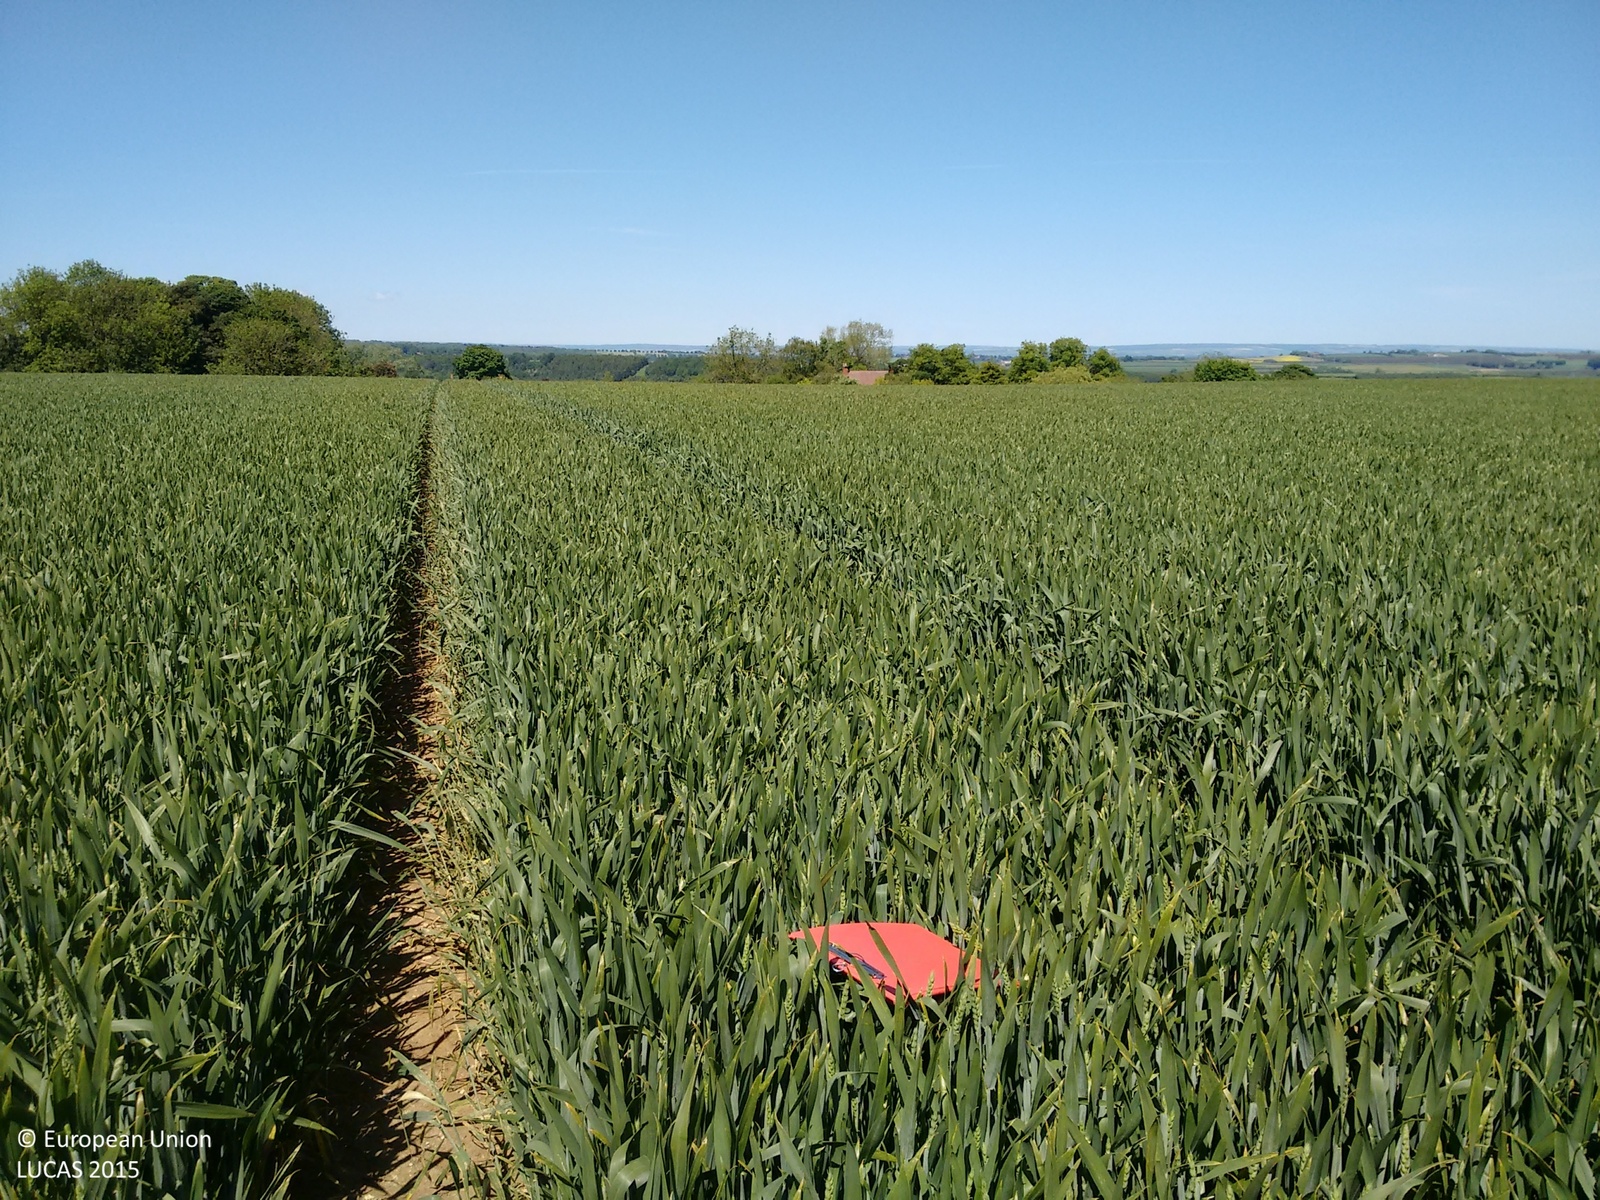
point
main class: Cropland
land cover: Common wheat
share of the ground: > 75 %
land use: Agriculture (excluding fallow land and kitchen gardens)
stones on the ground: < 10 %
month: June
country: GB
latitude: 54.0747
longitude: -0.8457
